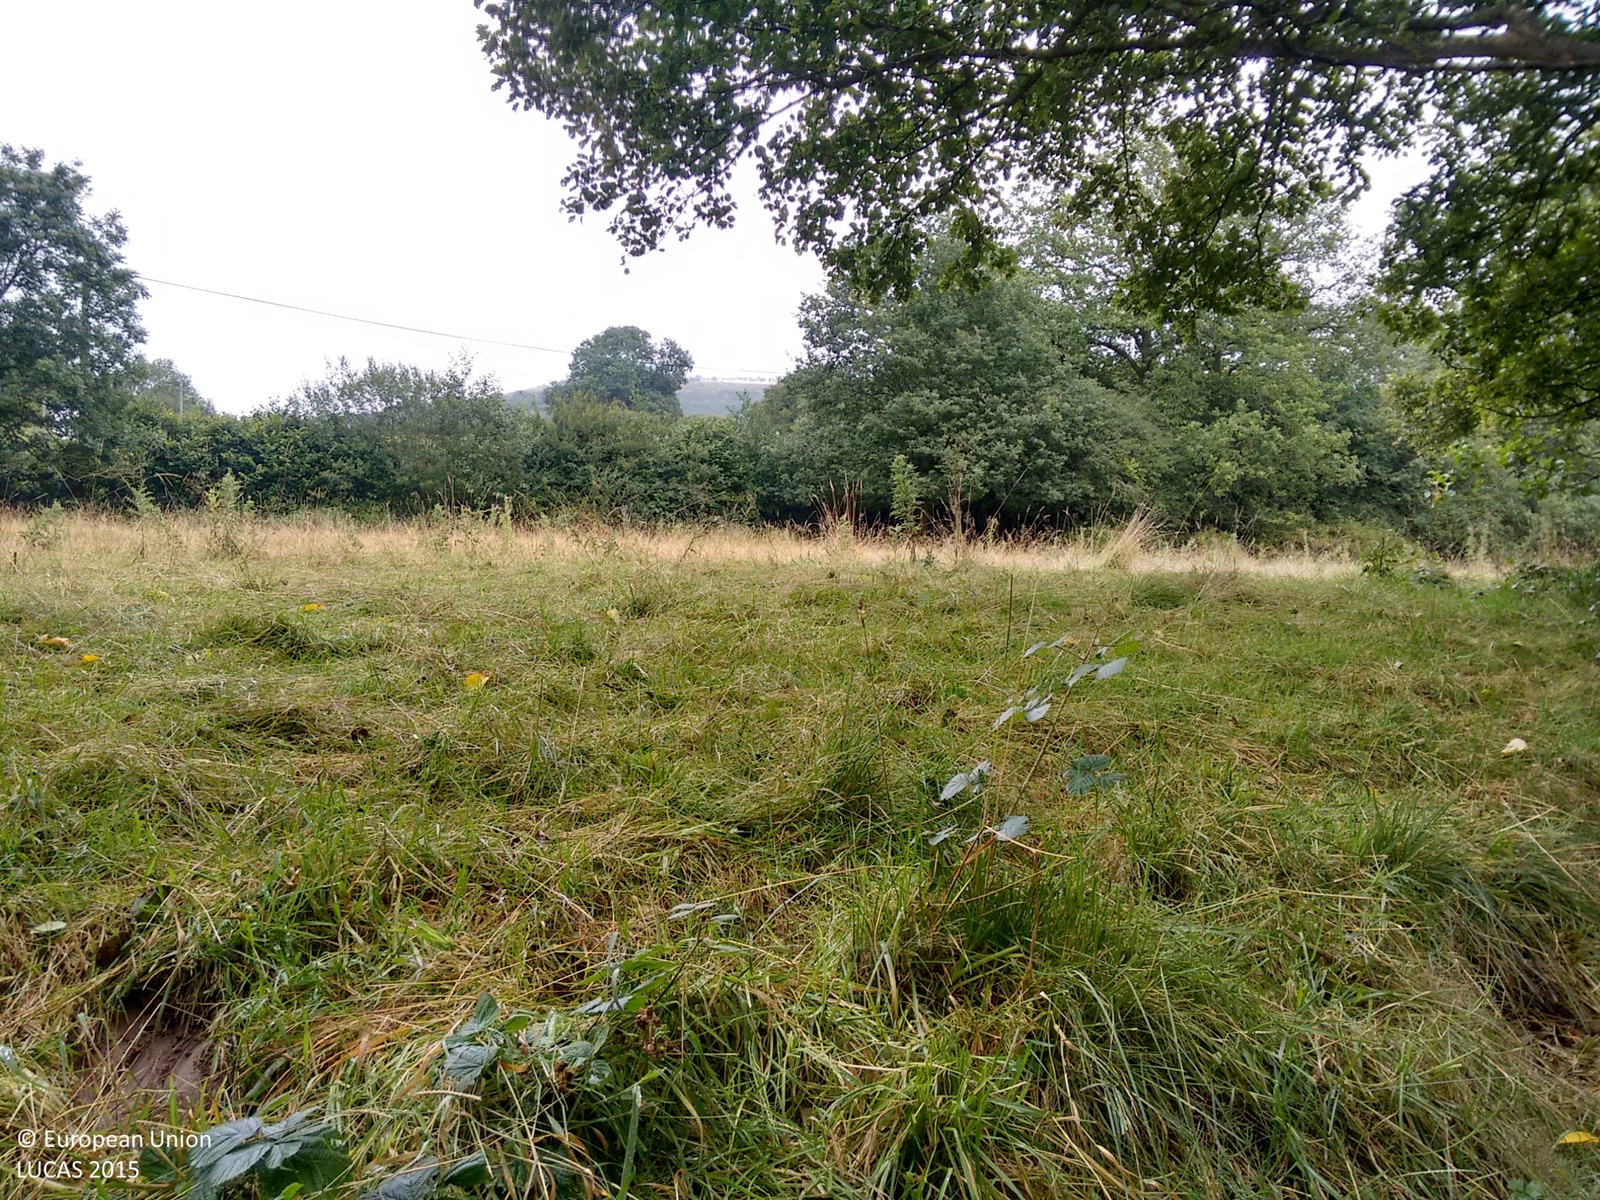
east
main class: Woodland
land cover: Other mixed woodland
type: mesophytic deciduous forest
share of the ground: > 75 %
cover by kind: broadleaved forest trees 60 %, coniferous forest trees 40 %
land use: Forestry
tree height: > 5 m
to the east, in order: Other mixed woodland; Grassland without tree/shrub cover; Groves; Grassland without tree/shrub cover; Broadleaved woodland; Inland fresh running water; Broadleaved woodland; Grassland without tree/shrub cover; Broadleaved woodland; Grass margins; Paved roads, cycling and walking lanes; Grass margins; Abandoned hedges; Fences; Grassland without tree/shrub cover; Electric lines; Grassland without tree/shrub cover; Fences; Abandoned hedges; Grassland without tree/shrub cover
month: September
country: GB
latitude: 52.5425
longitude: -2.9164
